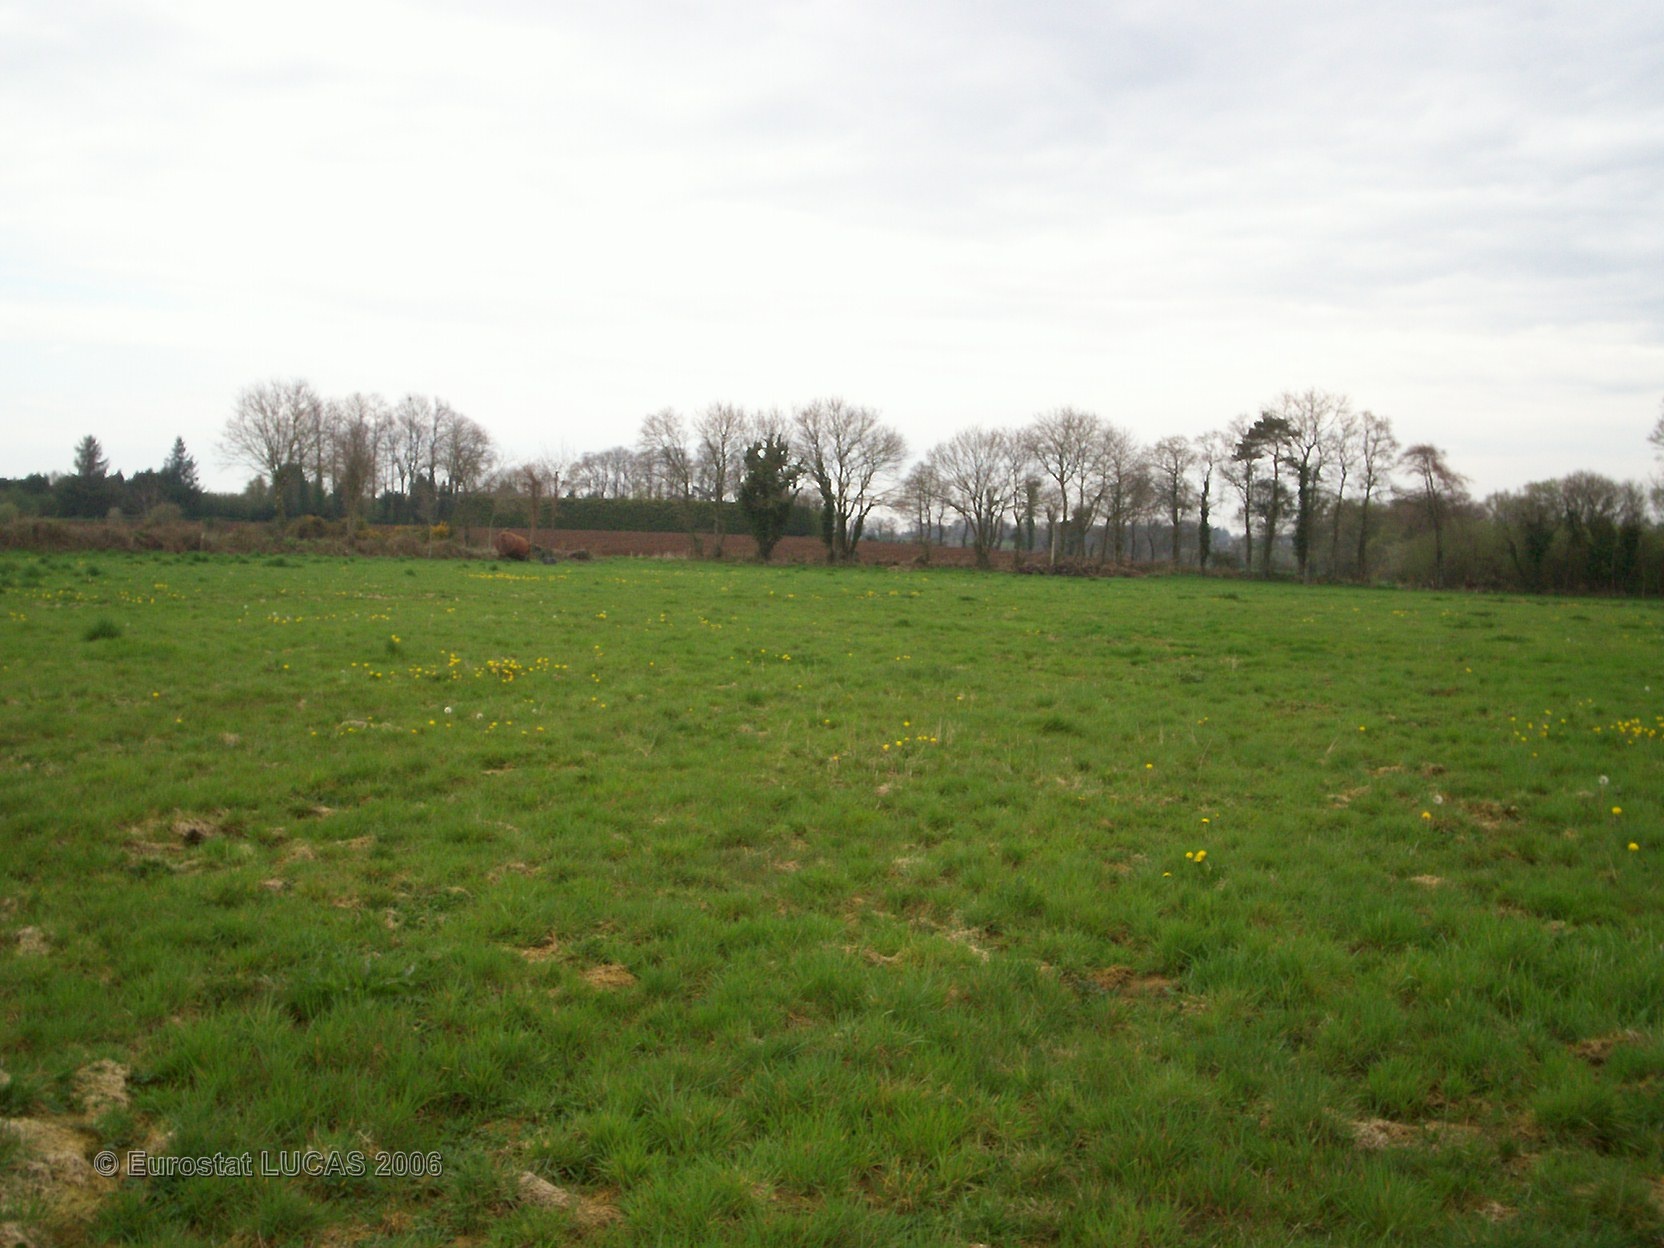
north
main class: Grassland
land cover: Grassland without tree/shrub cover
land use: Agriculture (excluding fallow land and kitchen gardens)
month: April
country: FR
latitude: 48.0330
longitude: -2.8461
